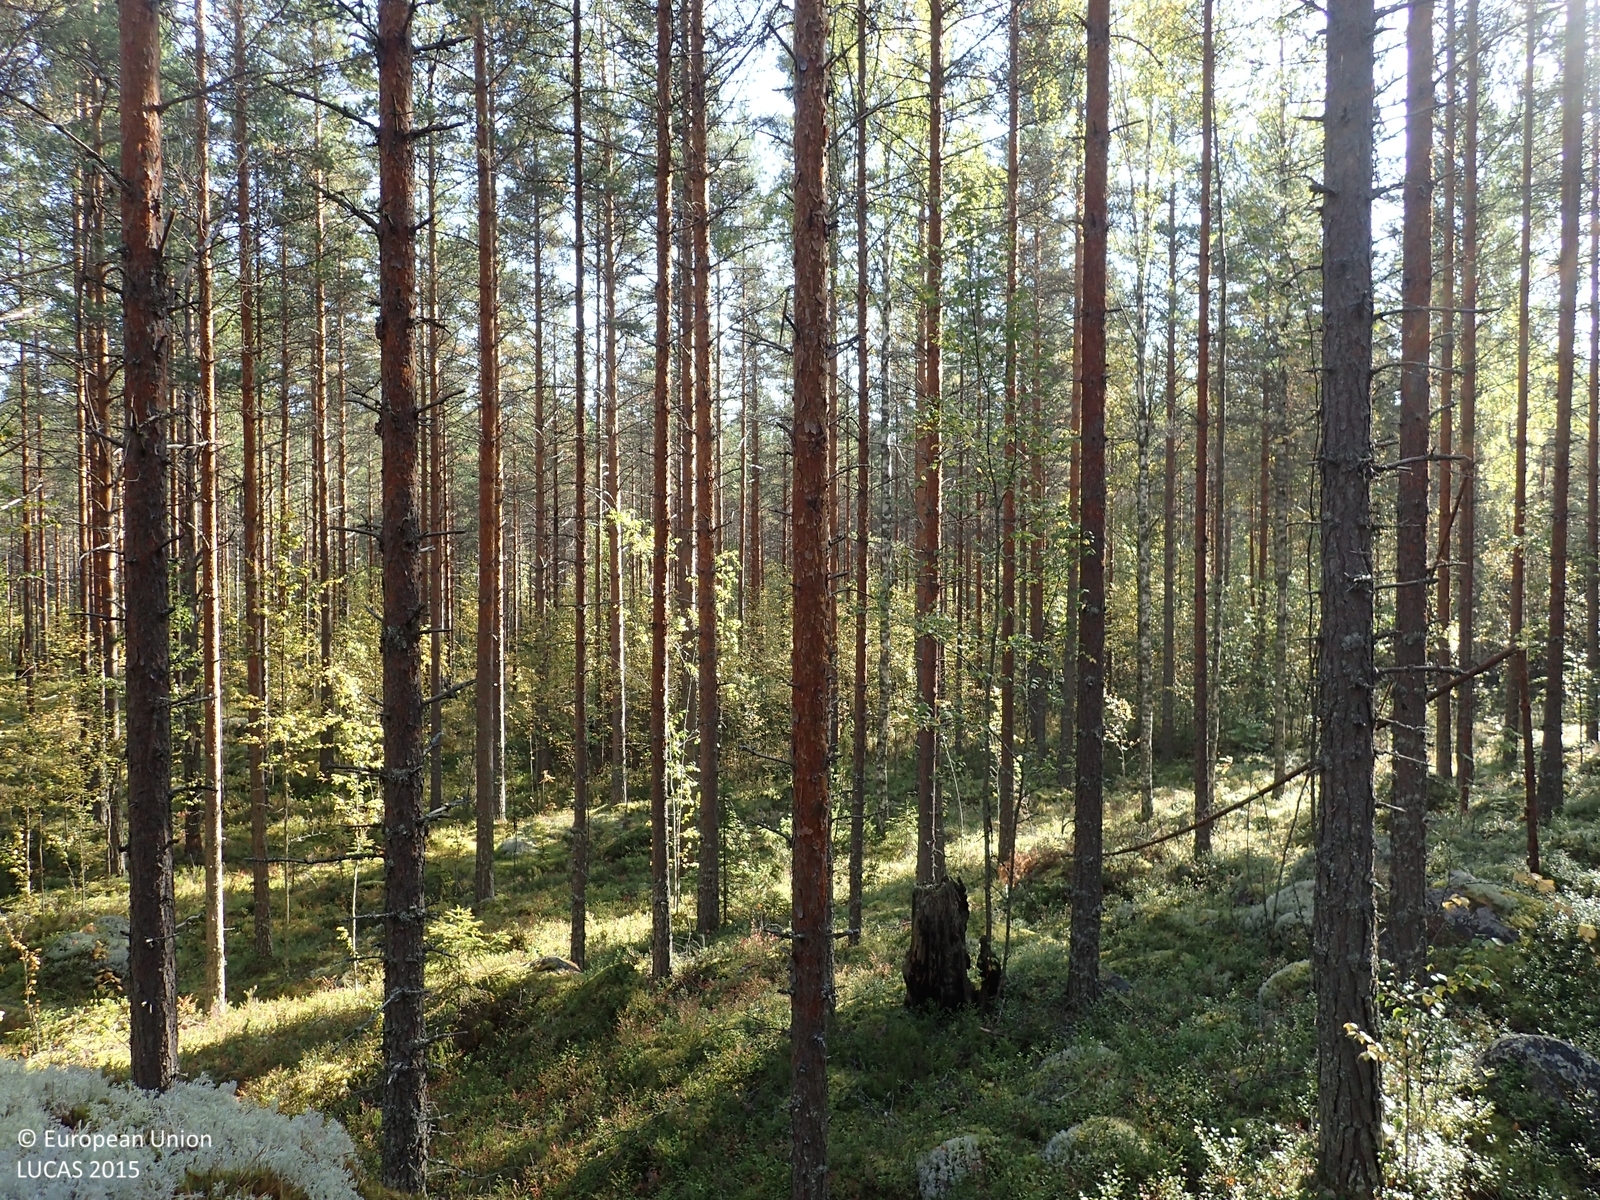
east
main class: Woodland
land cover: Pine dominated coniferous woodland
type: boreal forest
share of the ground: > 75 %
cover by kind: coniferous forest trees 65 %, shrubs 15 %, broadleaved forest trees 10 %, lichens and mosses 5 %, consolidated bare surface 5 %
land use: Forestry
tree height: > 5 m
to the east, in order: Pine dominated coniferous woodland; Pine dominated mixed woodland; Ditches and canals; Pine dominated mixed woodland; Ditches and canals; Pine dominated mixed woodland; Spruce dominated coniferous woodland; Rivers and streams; Spruce dominated coniferous woodland
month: September
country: FI
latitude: 62.9310
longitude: 25.2891
